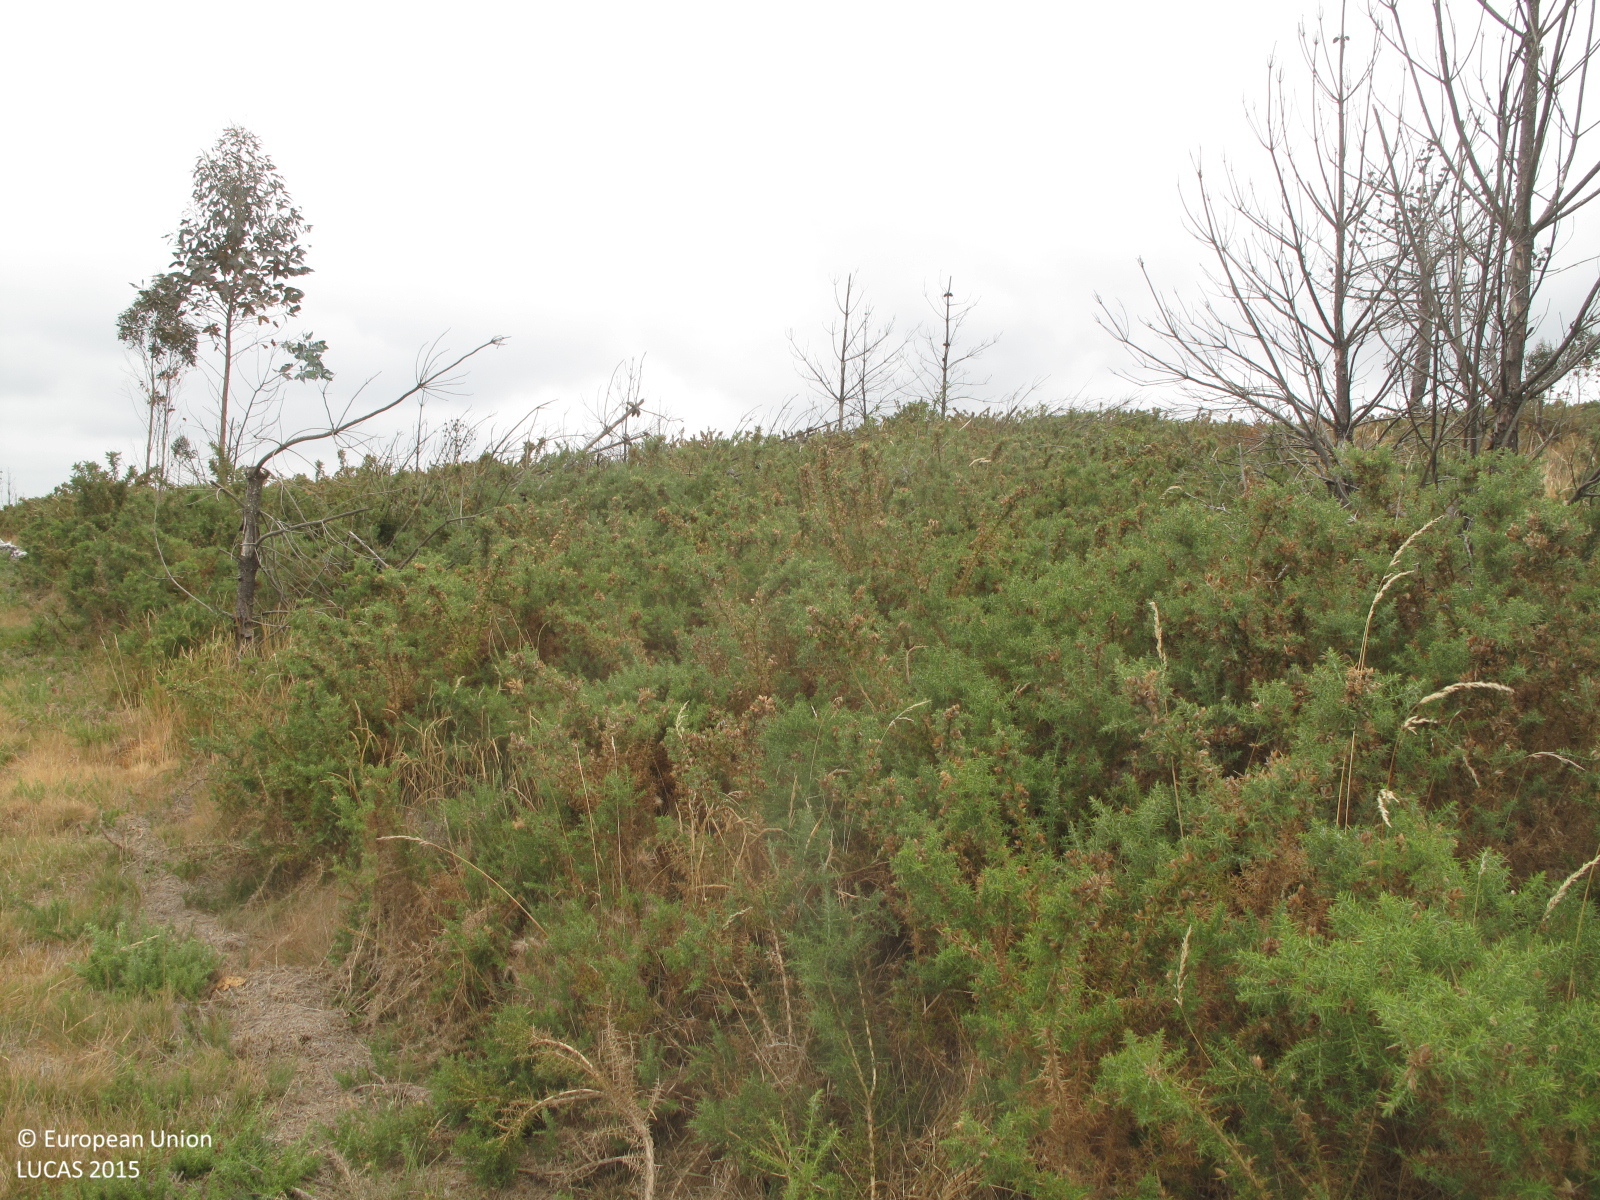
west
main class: Shrubland
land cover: Shrubland with sparse tree cover
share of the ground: > 75 %
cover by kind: shrubs 90 %, broadleaved forest trees 5 %, herbaceous plants 5 %
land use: Abandoned areas
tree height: < 5 m
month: July
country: ES
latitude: 43.4171
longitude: -8.0417
